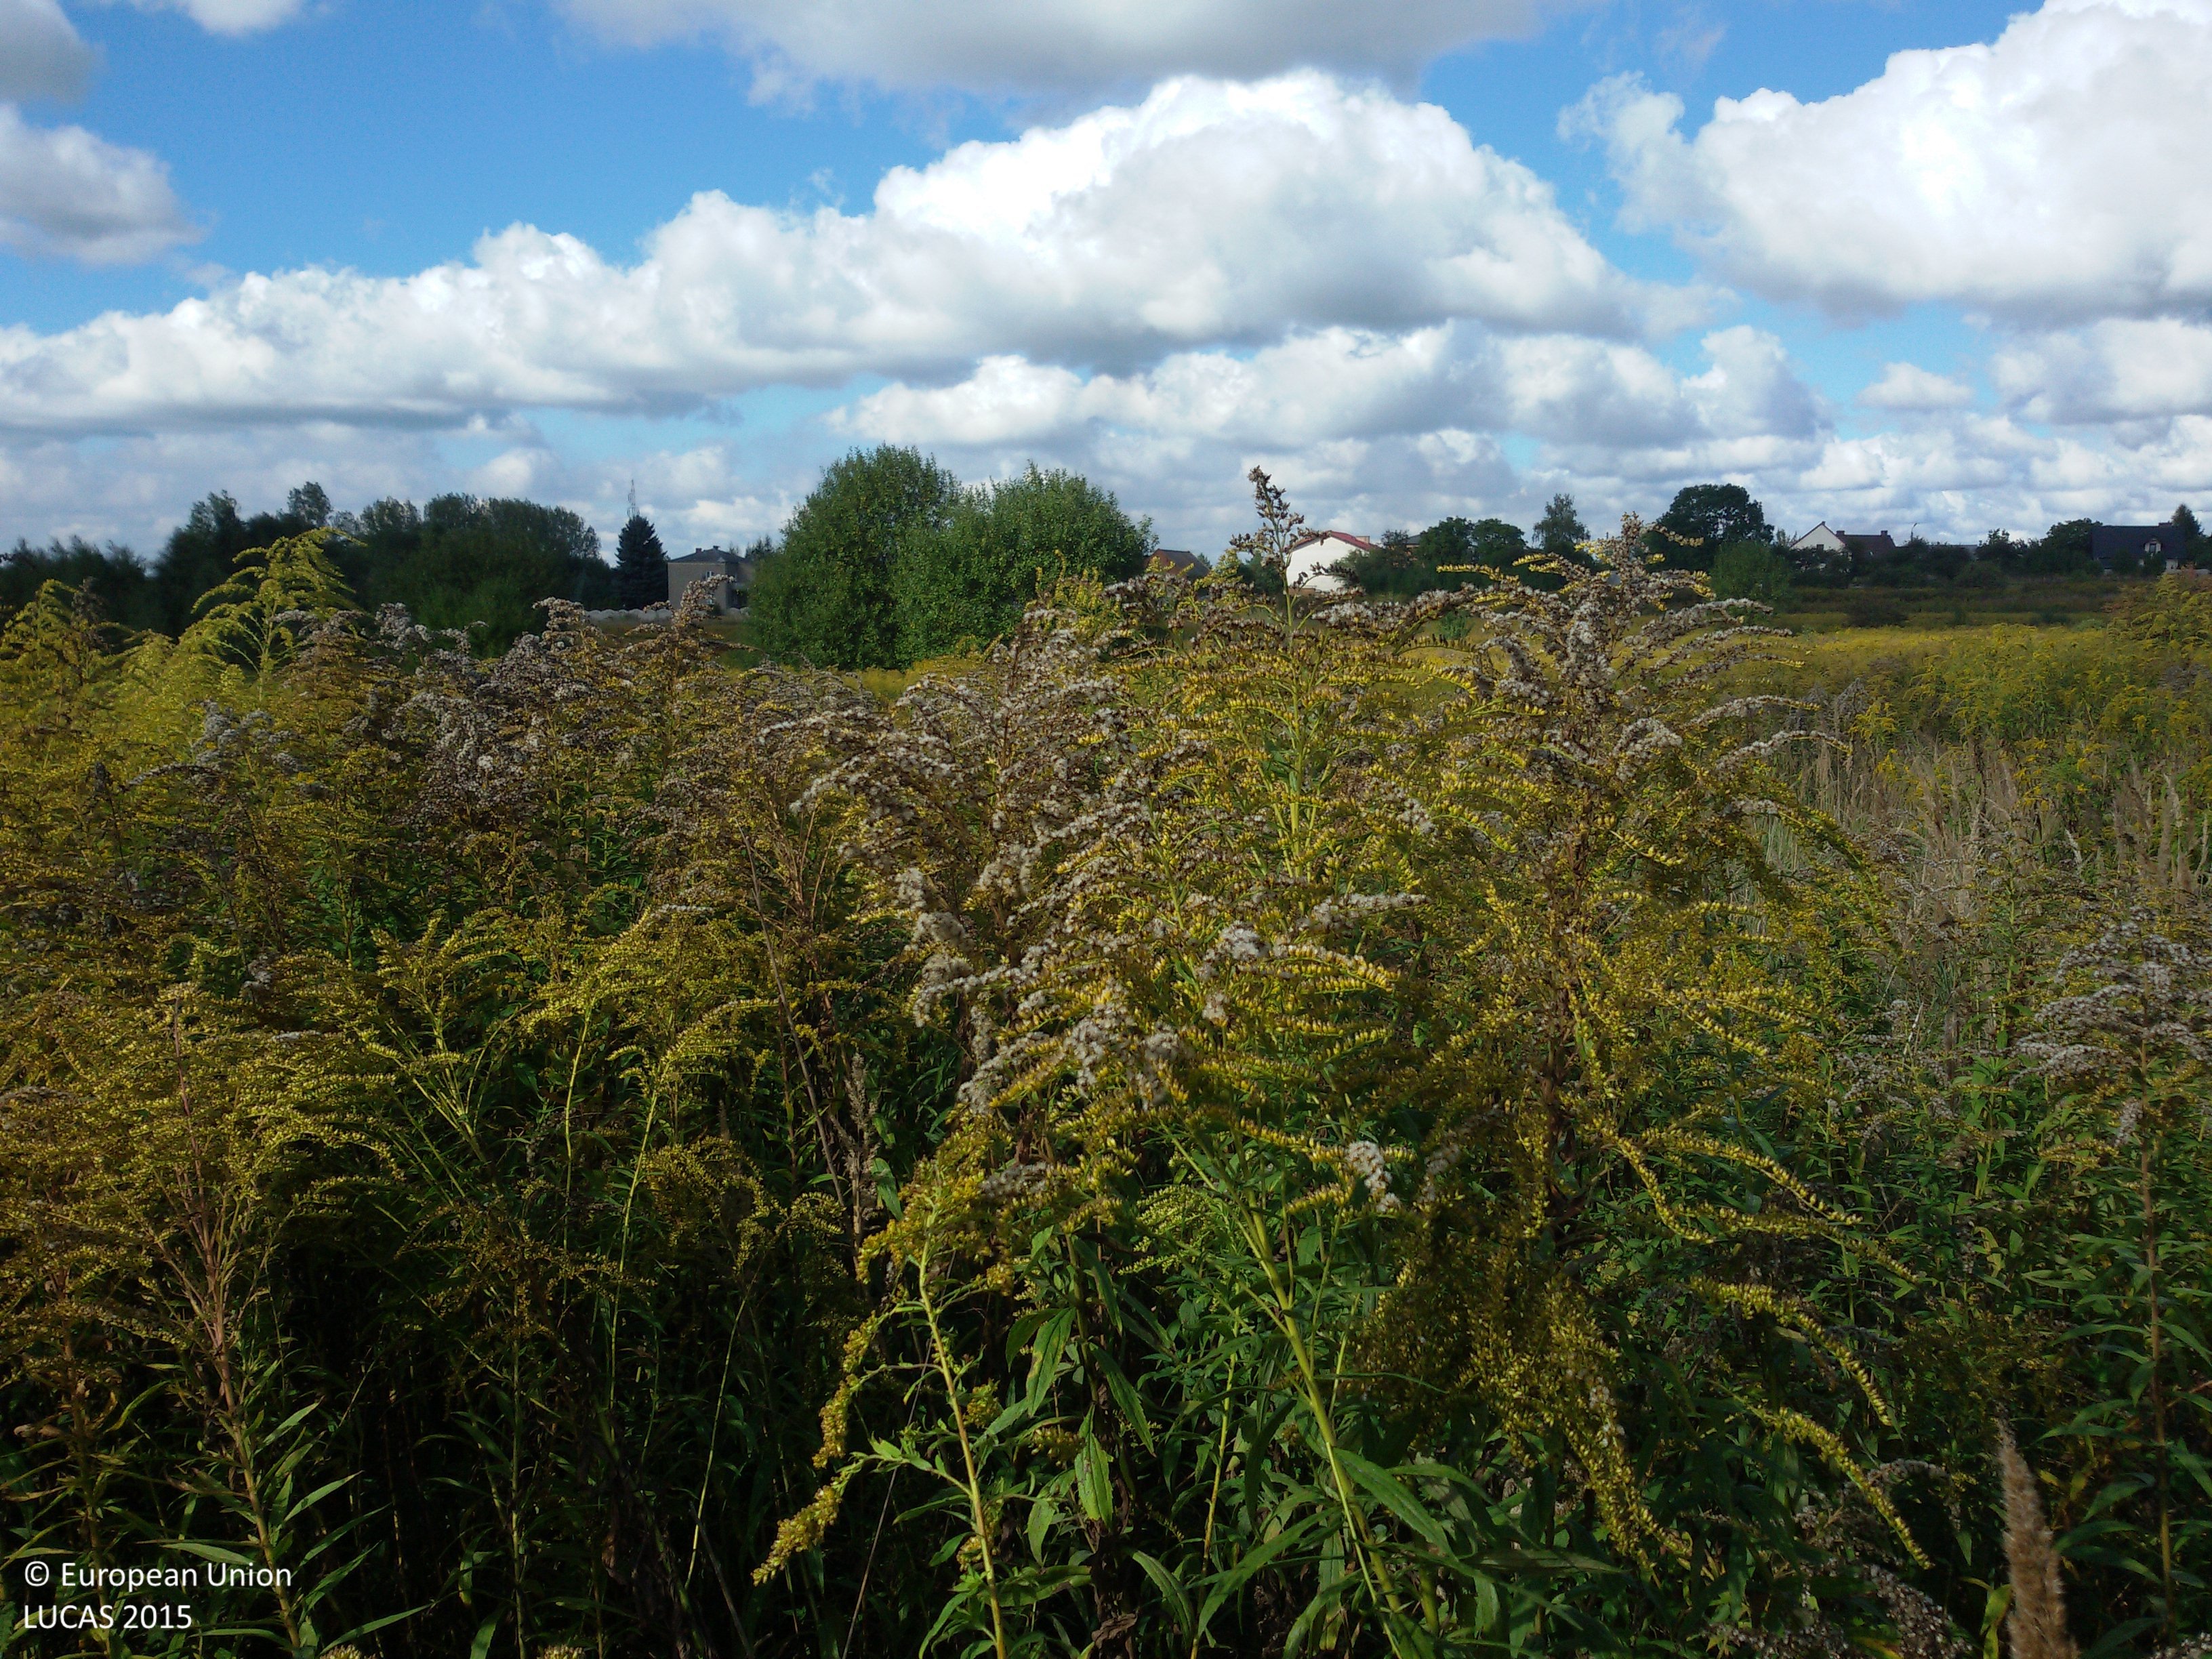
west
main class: Grassland
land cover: Spontaneously vegetated surfaces
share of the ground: > 75 %
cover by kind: herbaceous plants 100 %
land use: Fallow land
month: September
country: PL
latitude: 50.3005
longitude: 19.4189
